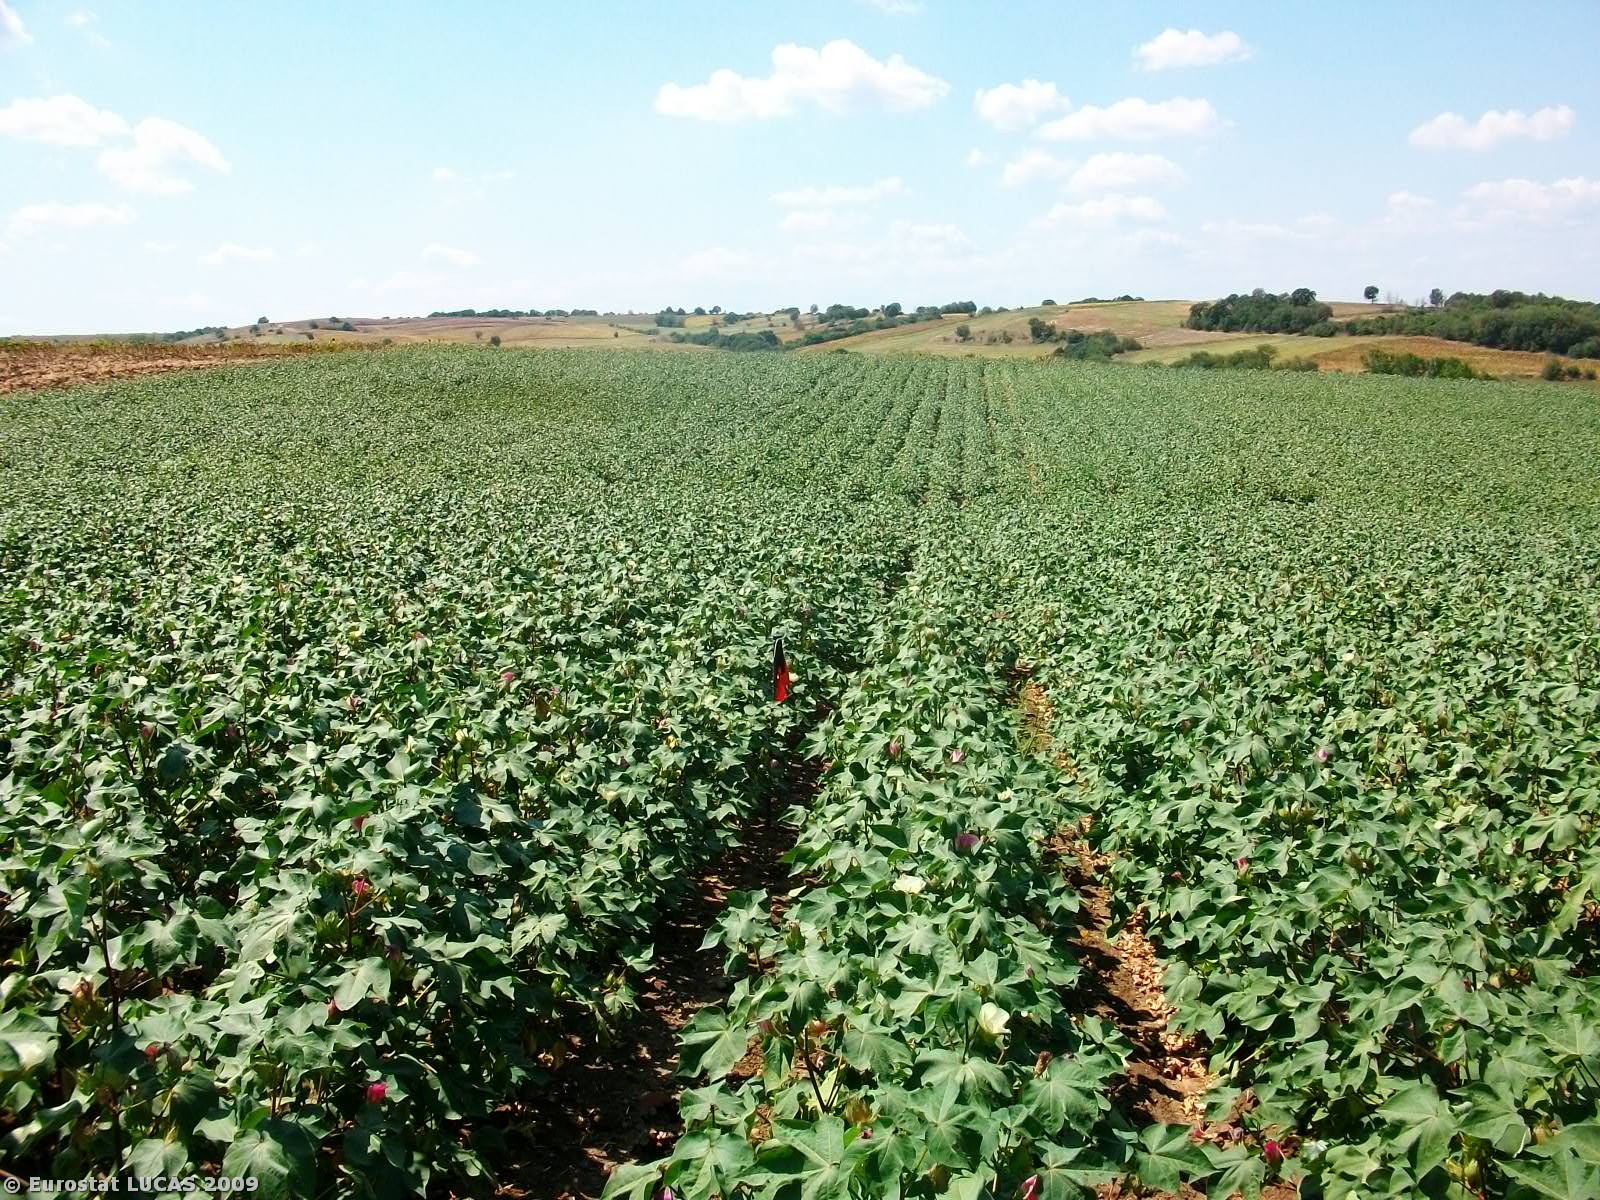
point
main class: Cropland
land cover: Cotton
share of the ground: 50 - 75 %
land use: Agriculture (excluding fallow land and kitchen gardens)
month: August
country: GR
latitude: 41.4824
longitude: 26.4488
